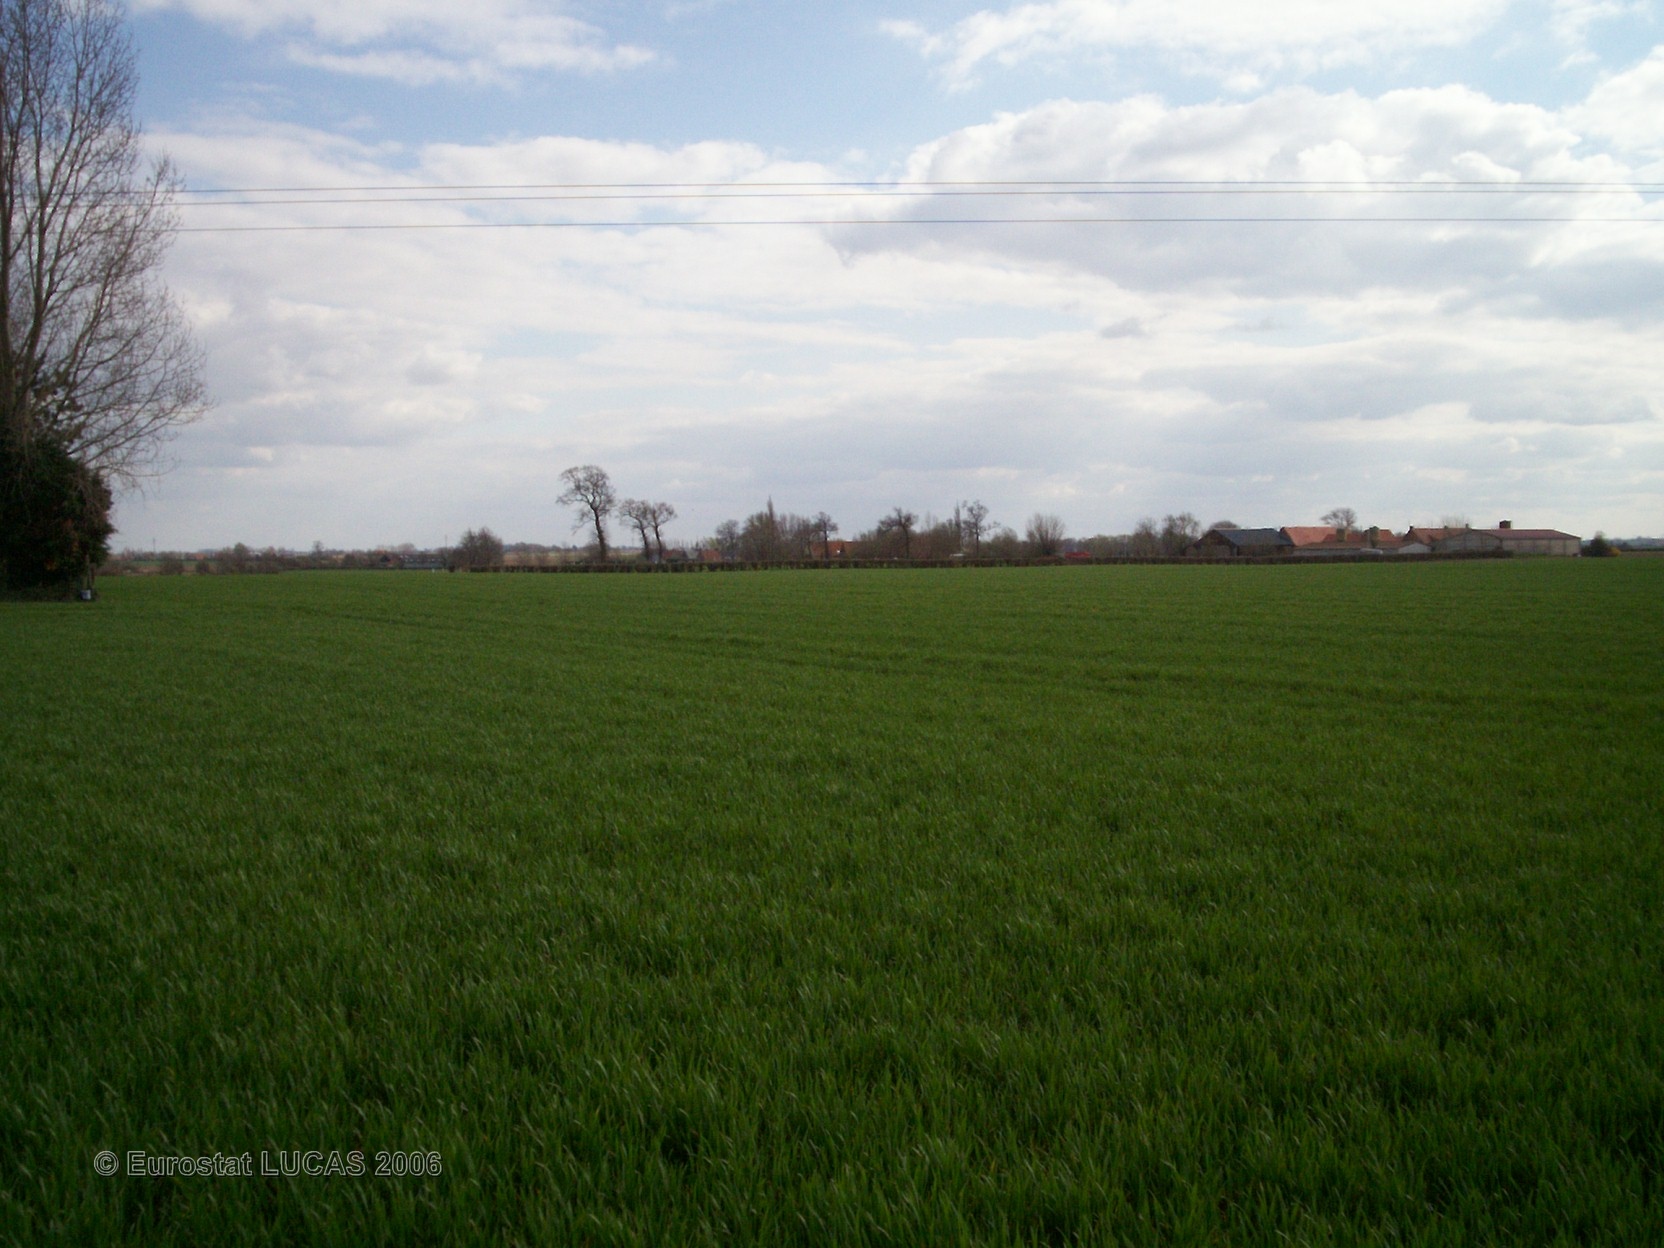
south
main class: Cropland
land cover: Common wheat
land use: Agriculture (excluding fallow land and kitchen gardens)
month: April
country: FR
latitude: 50.8883
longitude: 2.4098
